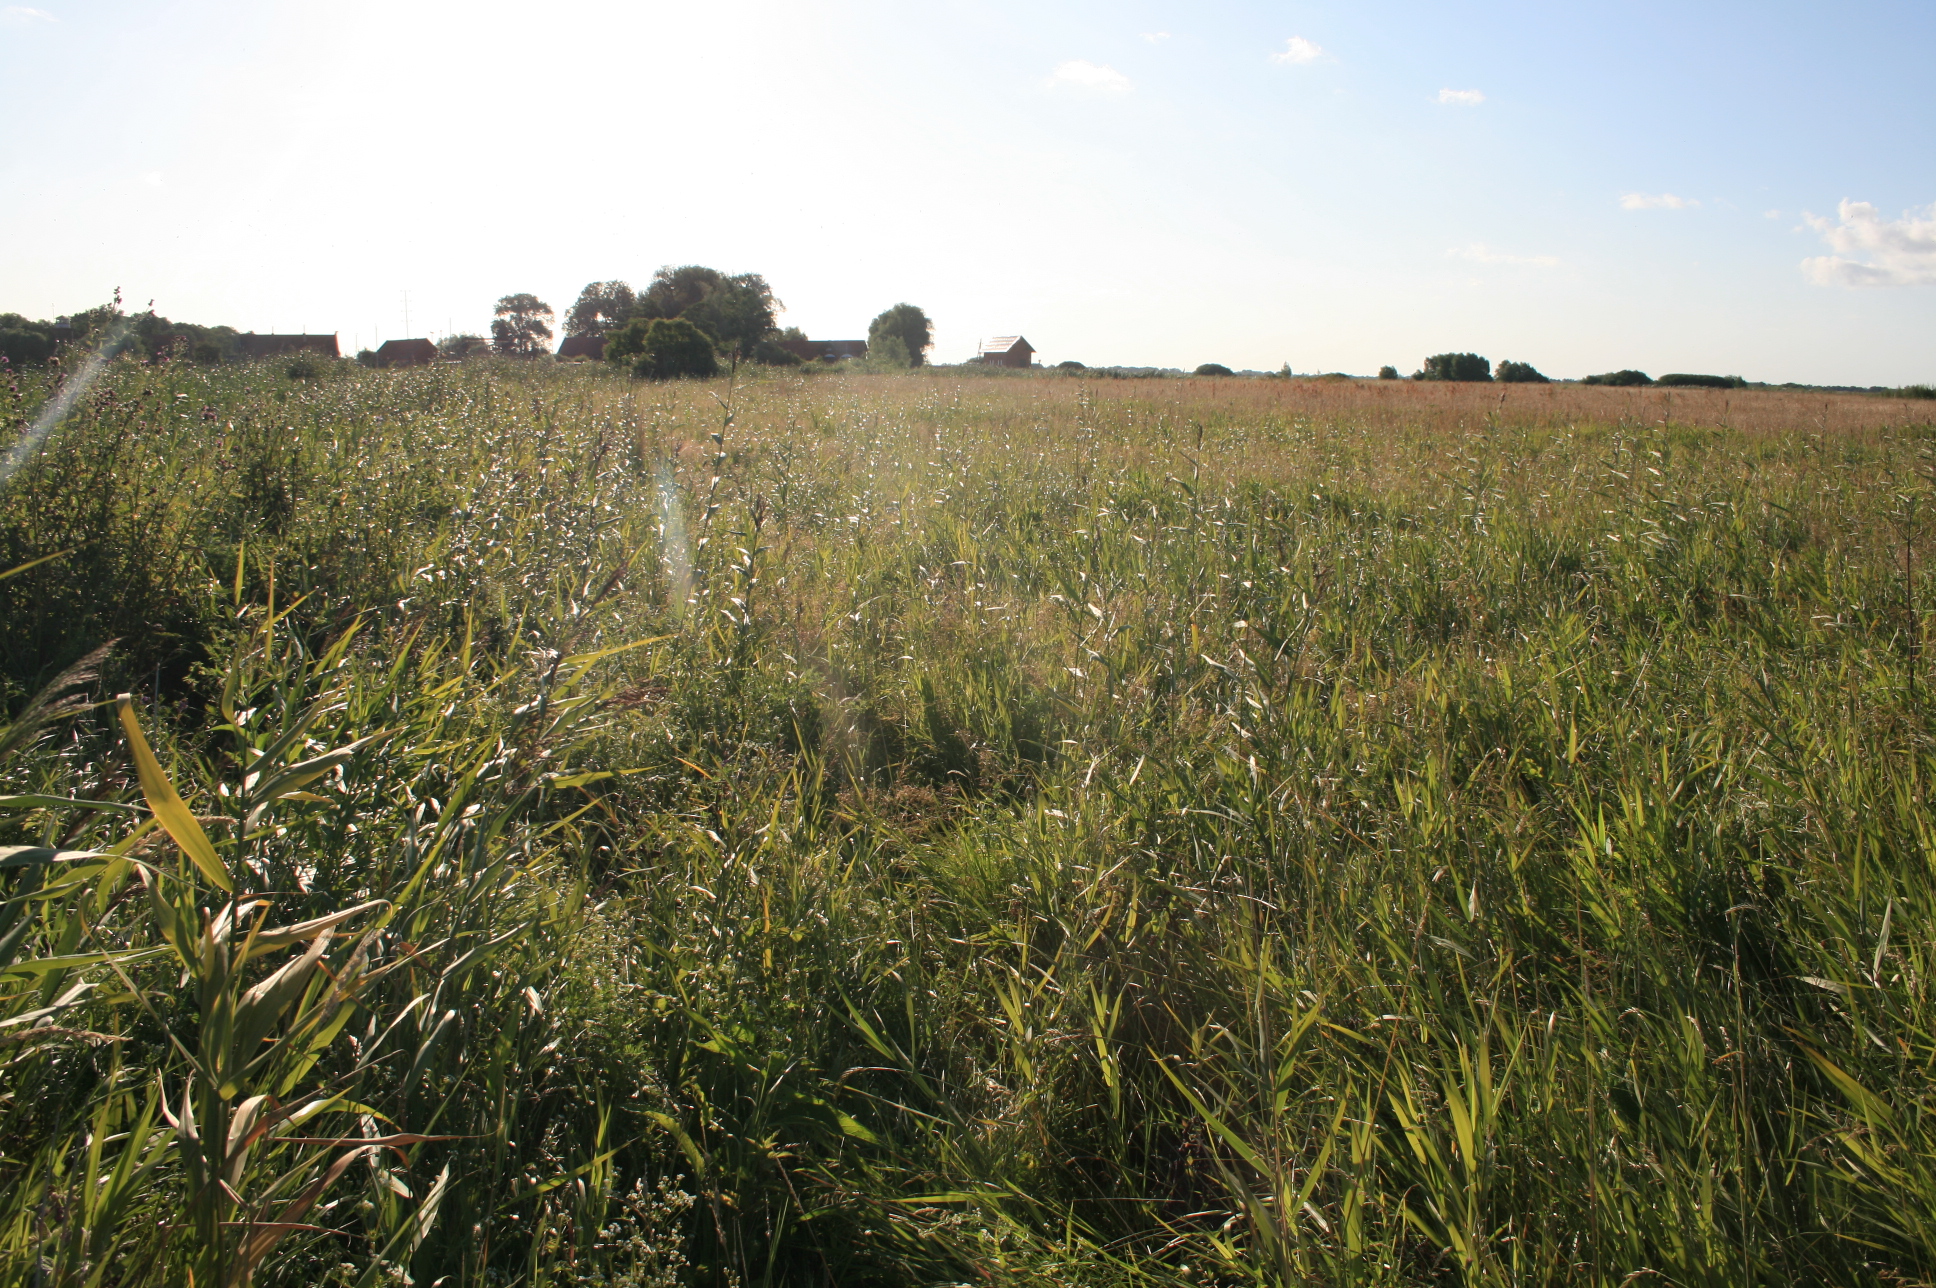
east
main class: Grassland
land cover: Spontaneously vegetated surfaces
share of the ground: > 75 %
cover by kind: herbaceous plants 100 %
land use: Semi-natural and natural areas not in use
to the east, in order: Spontaneously vegetated surfaces; Inland fresh running water; Spontaneously vegetated surfaces; Grassland without tree/shrub cover; Shruby margins; Paved roads, cycling and walking lanes
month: July
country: LT
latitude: 55.3428
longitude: 21.2859
